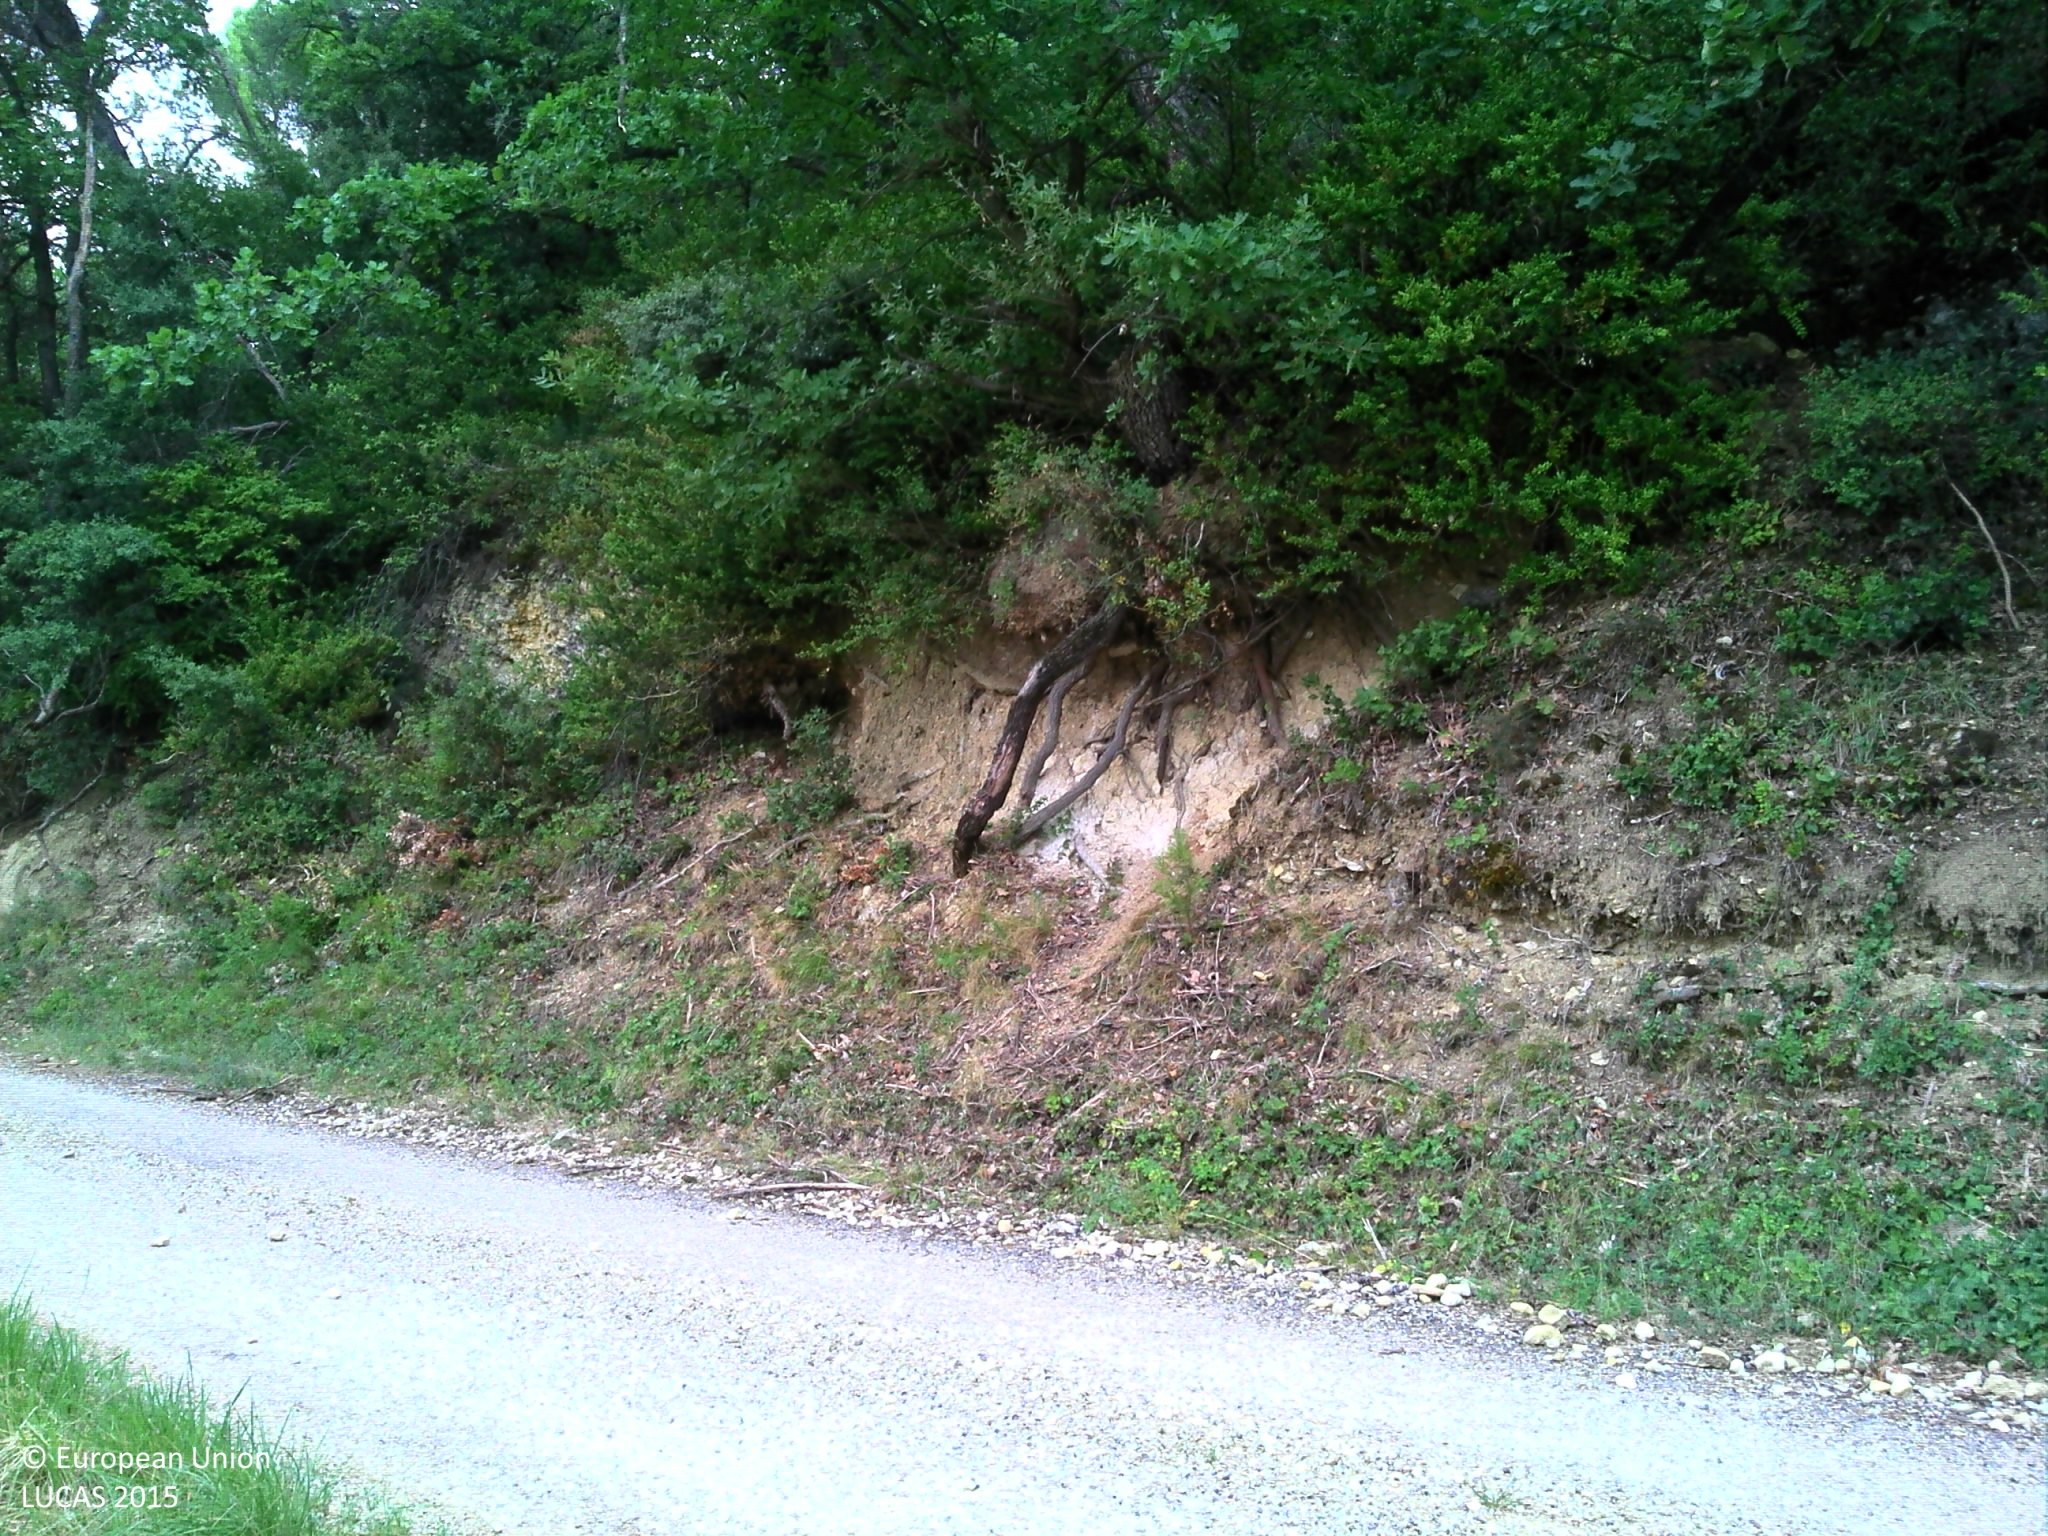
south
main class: Woodland
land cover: Broadleaved woodland
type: thermophilous deciduous forest
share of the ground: > 75 %
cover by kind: broadleaved forest trees 90 %, coniferous forest trees 5 %, herbaceous plants 5 %
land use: Forestry
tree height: > 5 m
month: September
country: FR
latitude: 44.3062
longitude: 5.0811
